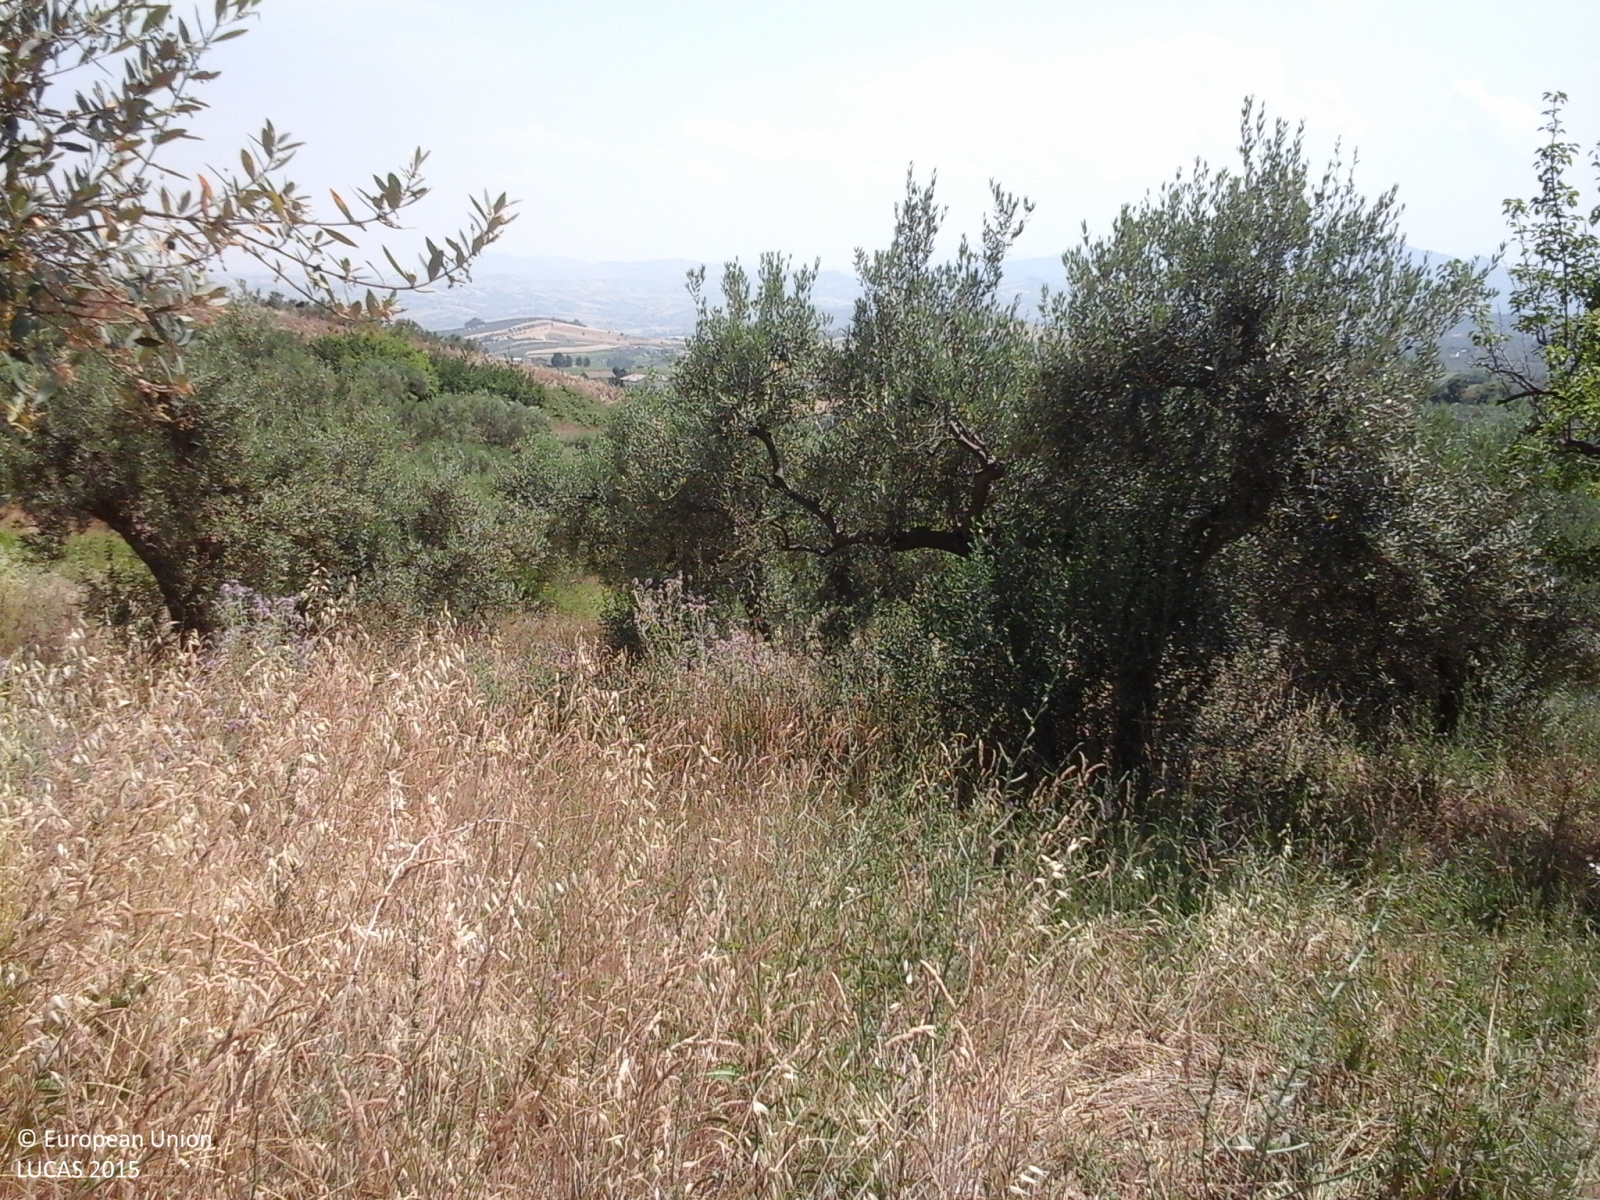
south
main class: Cropland
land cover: Vineyards
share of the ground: 25 - 50 %
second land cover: Spontaneously vegetated surfaces
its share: 25 - 50 %
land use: Agriculture (excluding fallow land and kitchen gardens)
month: June
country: IT
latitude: 42.1964
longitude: 14.4066
